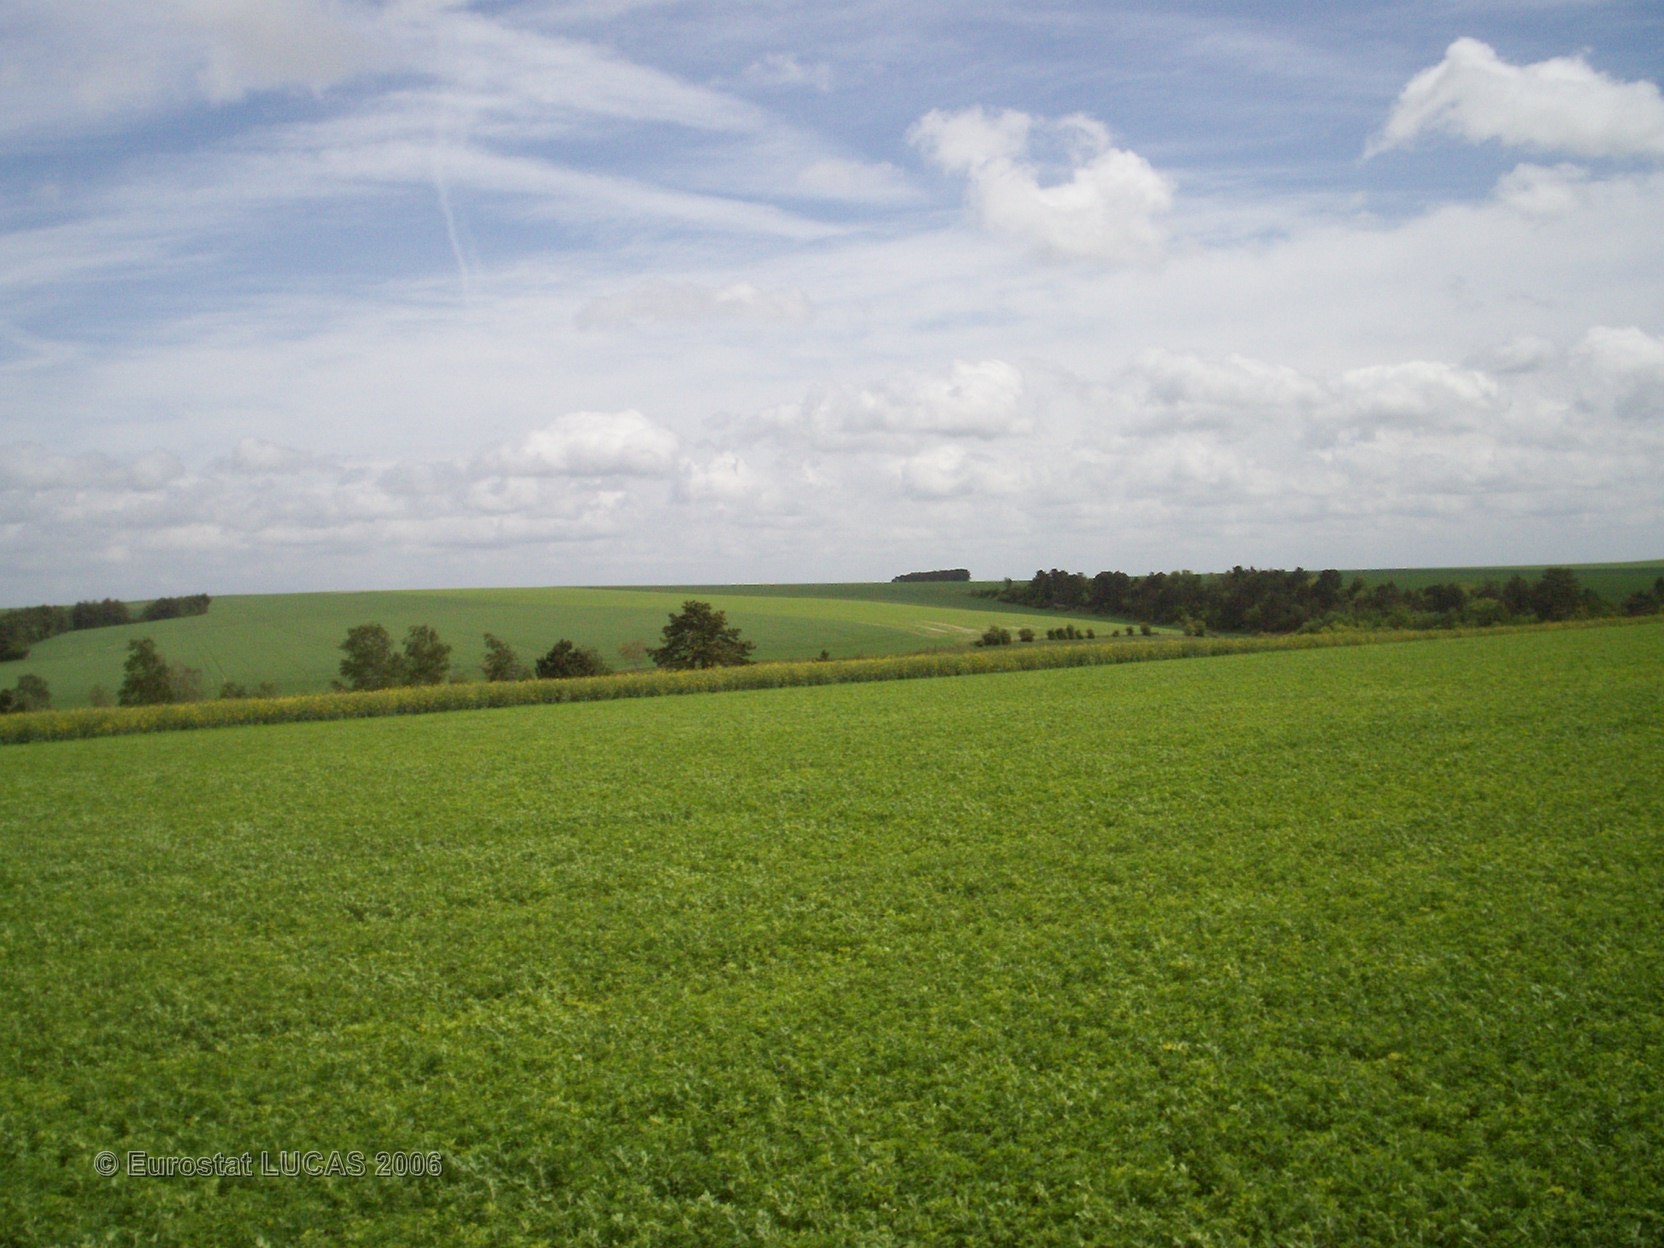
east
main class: Cropland
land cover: Lucerne
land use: Agriculture (excluding fallow land and kitchen gardens)
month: May
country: FR
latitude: 49.3168
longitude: 4.5903
